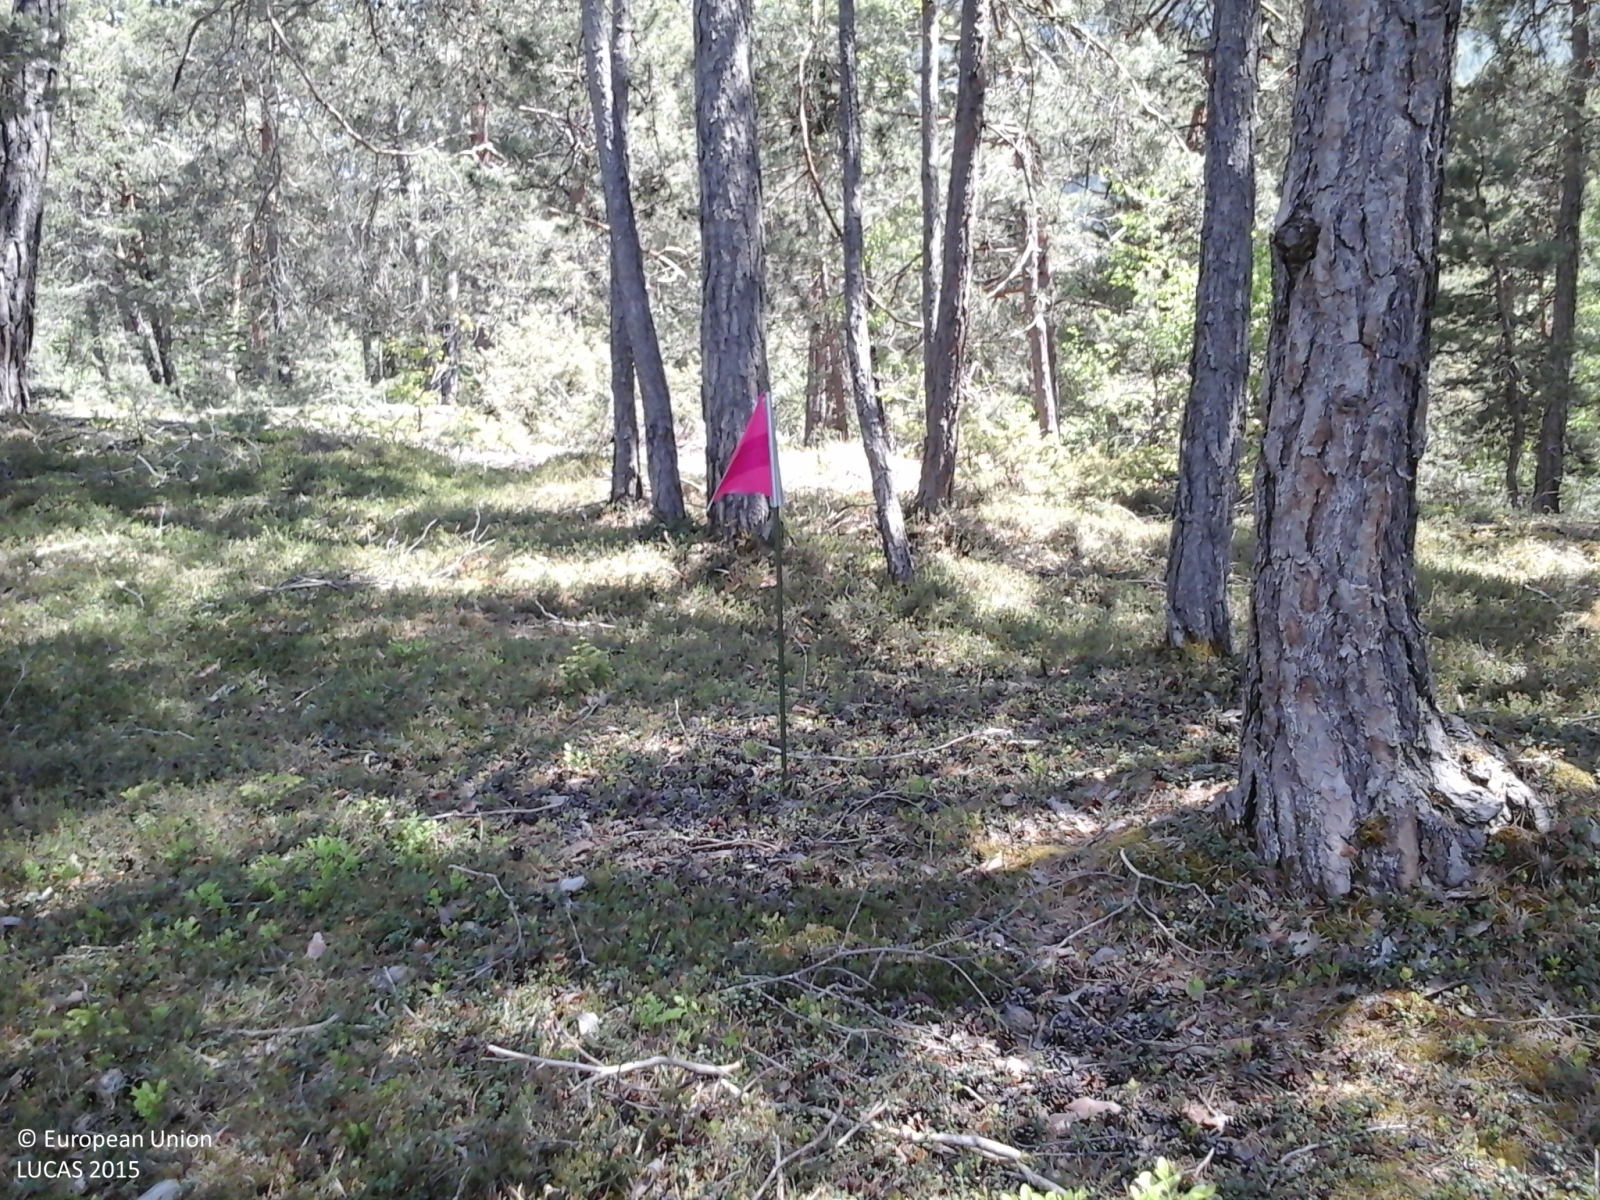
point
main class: Woodland
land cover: Pine dominated coniferous woodland
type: alpine coniferous forest
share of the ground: > 75 %
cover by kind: coniferous forest trees 100 %
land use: Forestry
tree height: > 5 m
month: May
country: IT
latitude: 46.5738
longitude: 11.5770
